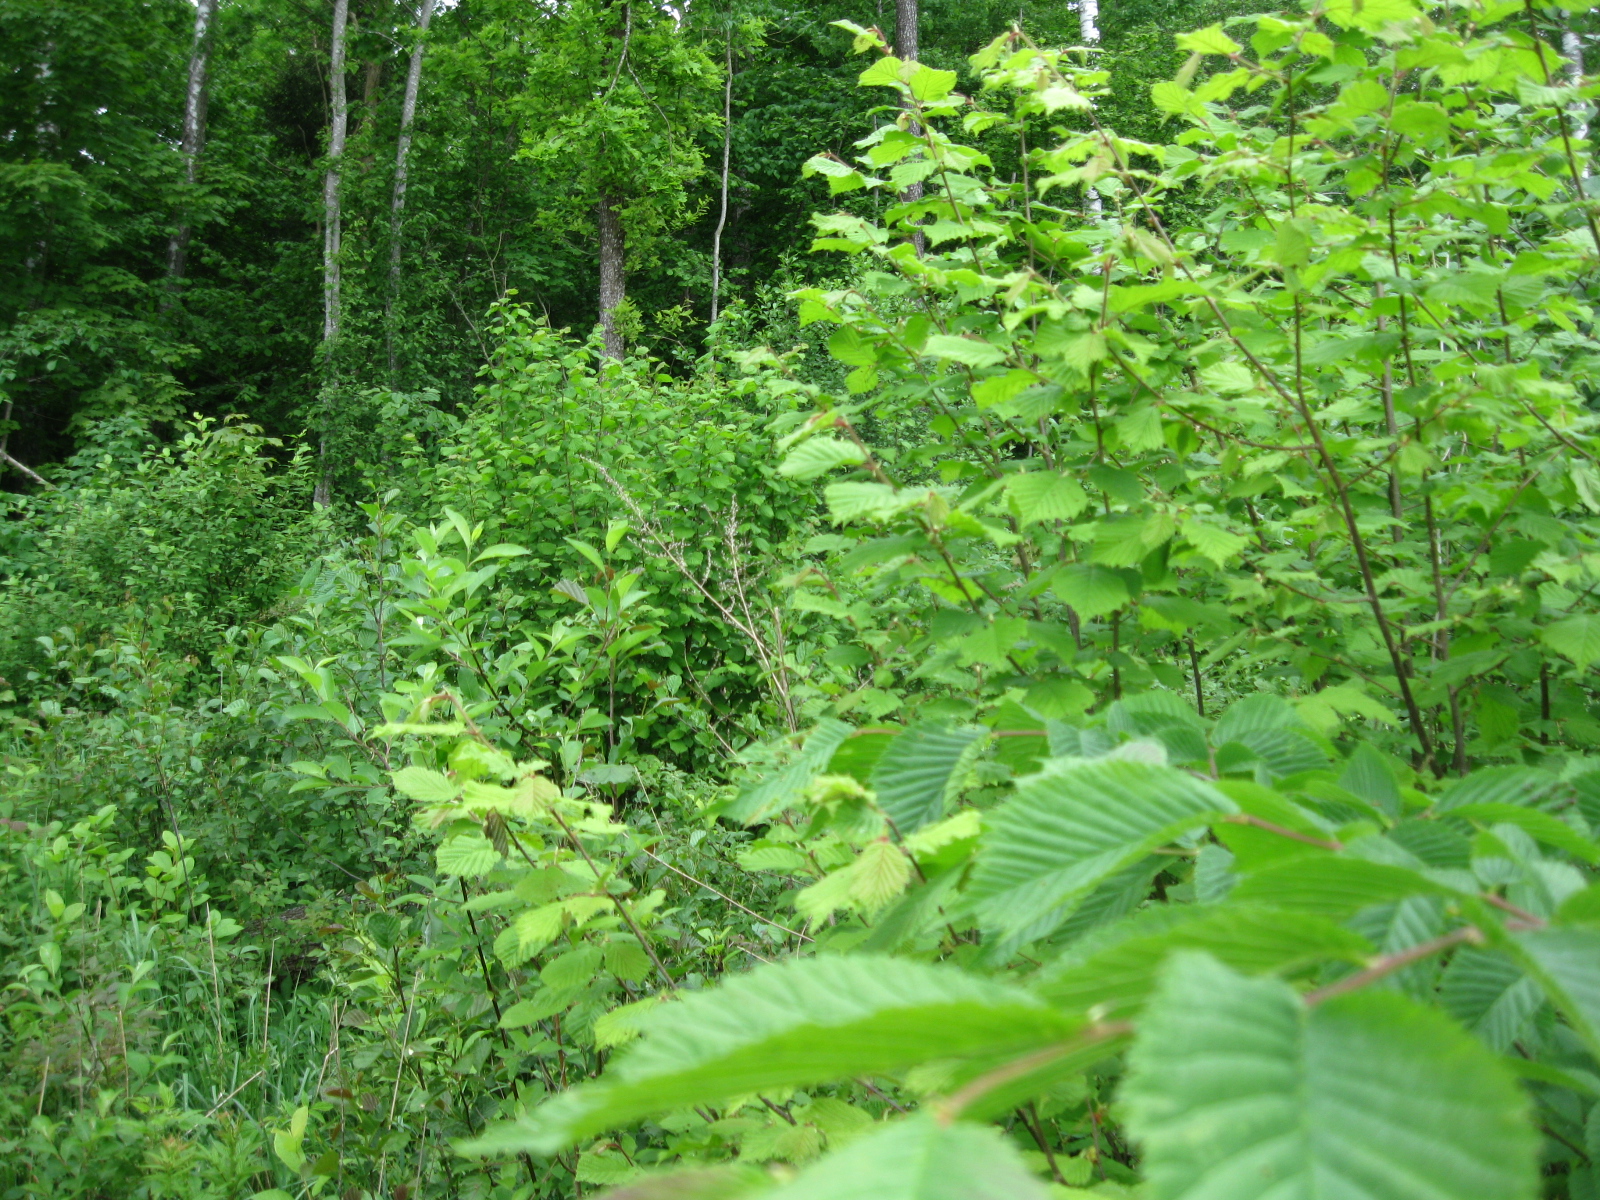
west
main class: Woodland
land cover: Broadleaved woodland
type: non-riverine alder, birch or aspen forest
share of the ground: > 75 %
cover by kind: broadleaved forest trees 80 %, shrubs 15 %, herbaceous plants 5 %
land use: Forestry
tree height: < 5 m
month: June
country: LT
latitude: 55.8817
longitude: 24.0770
